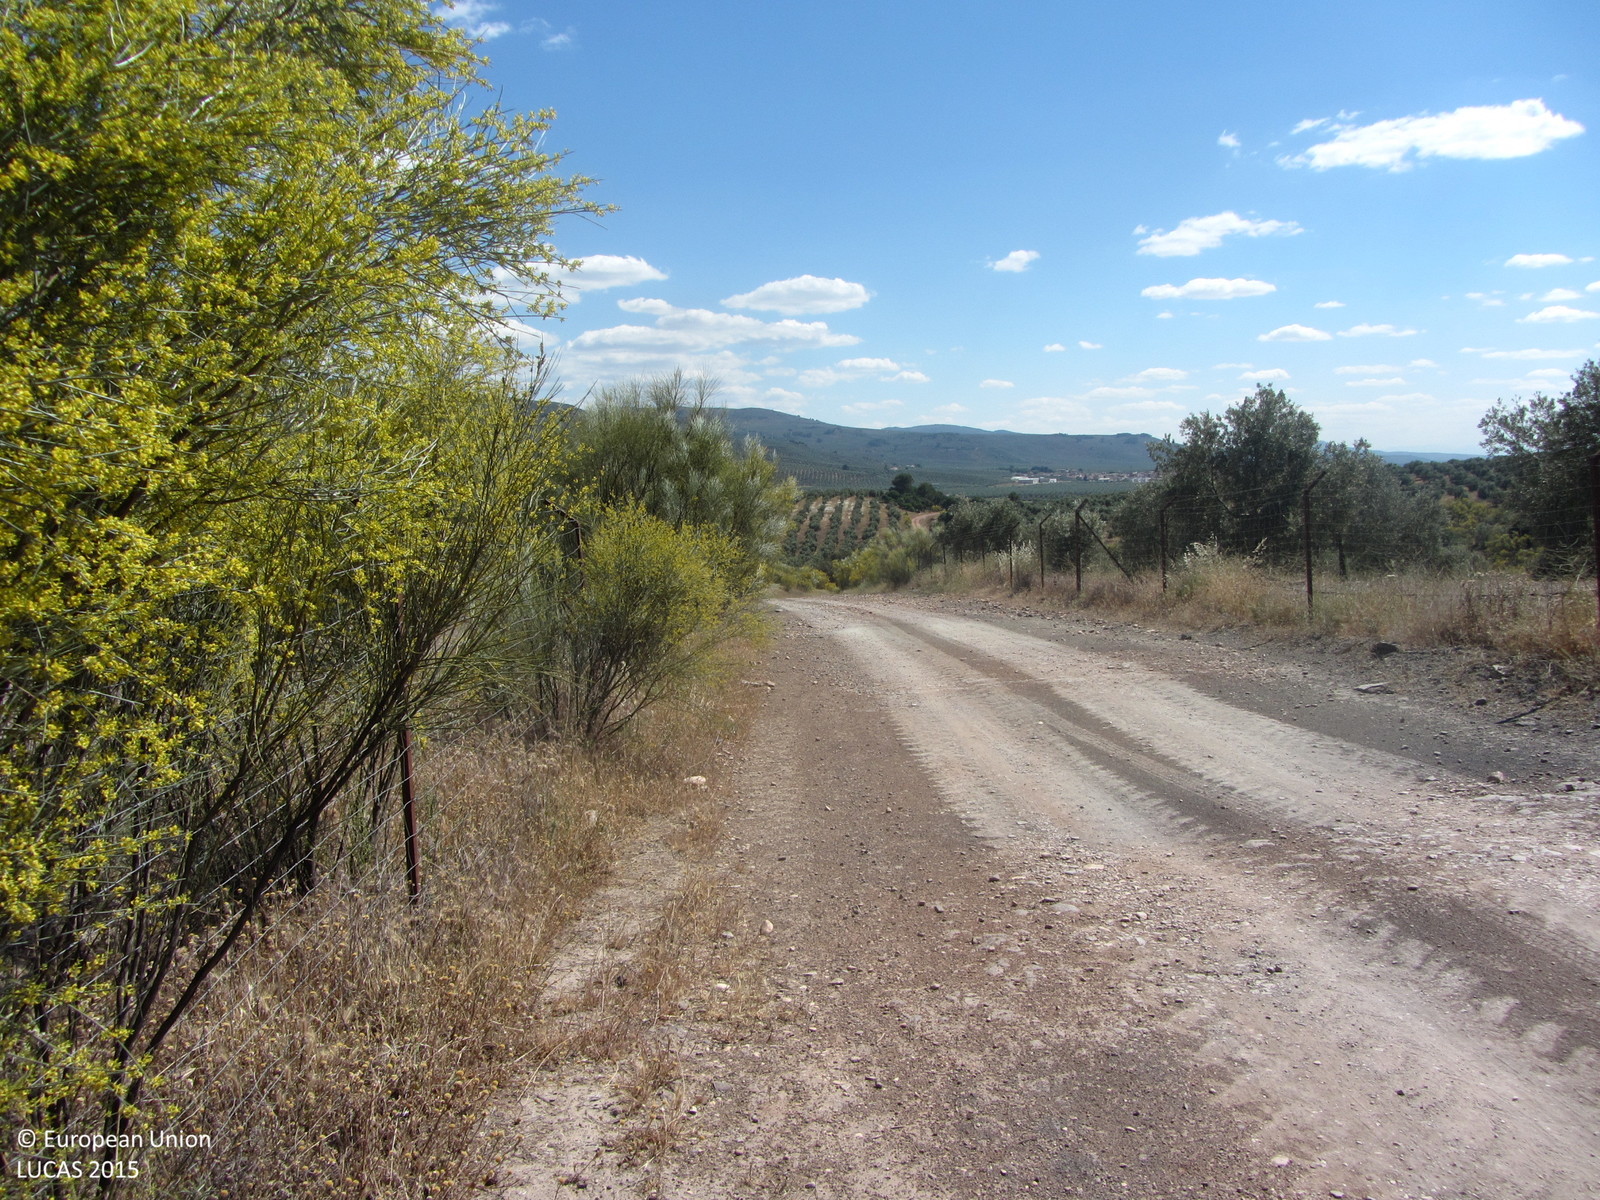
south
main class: Cropland
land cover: Olive groves
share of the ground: 25 - 50 %
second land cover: Other bare soil
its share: > 75 %
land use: Agriculture (excluding fallow land and kitchen gardens)
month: May
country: ES
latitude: 38.3534
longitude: -2.8738
